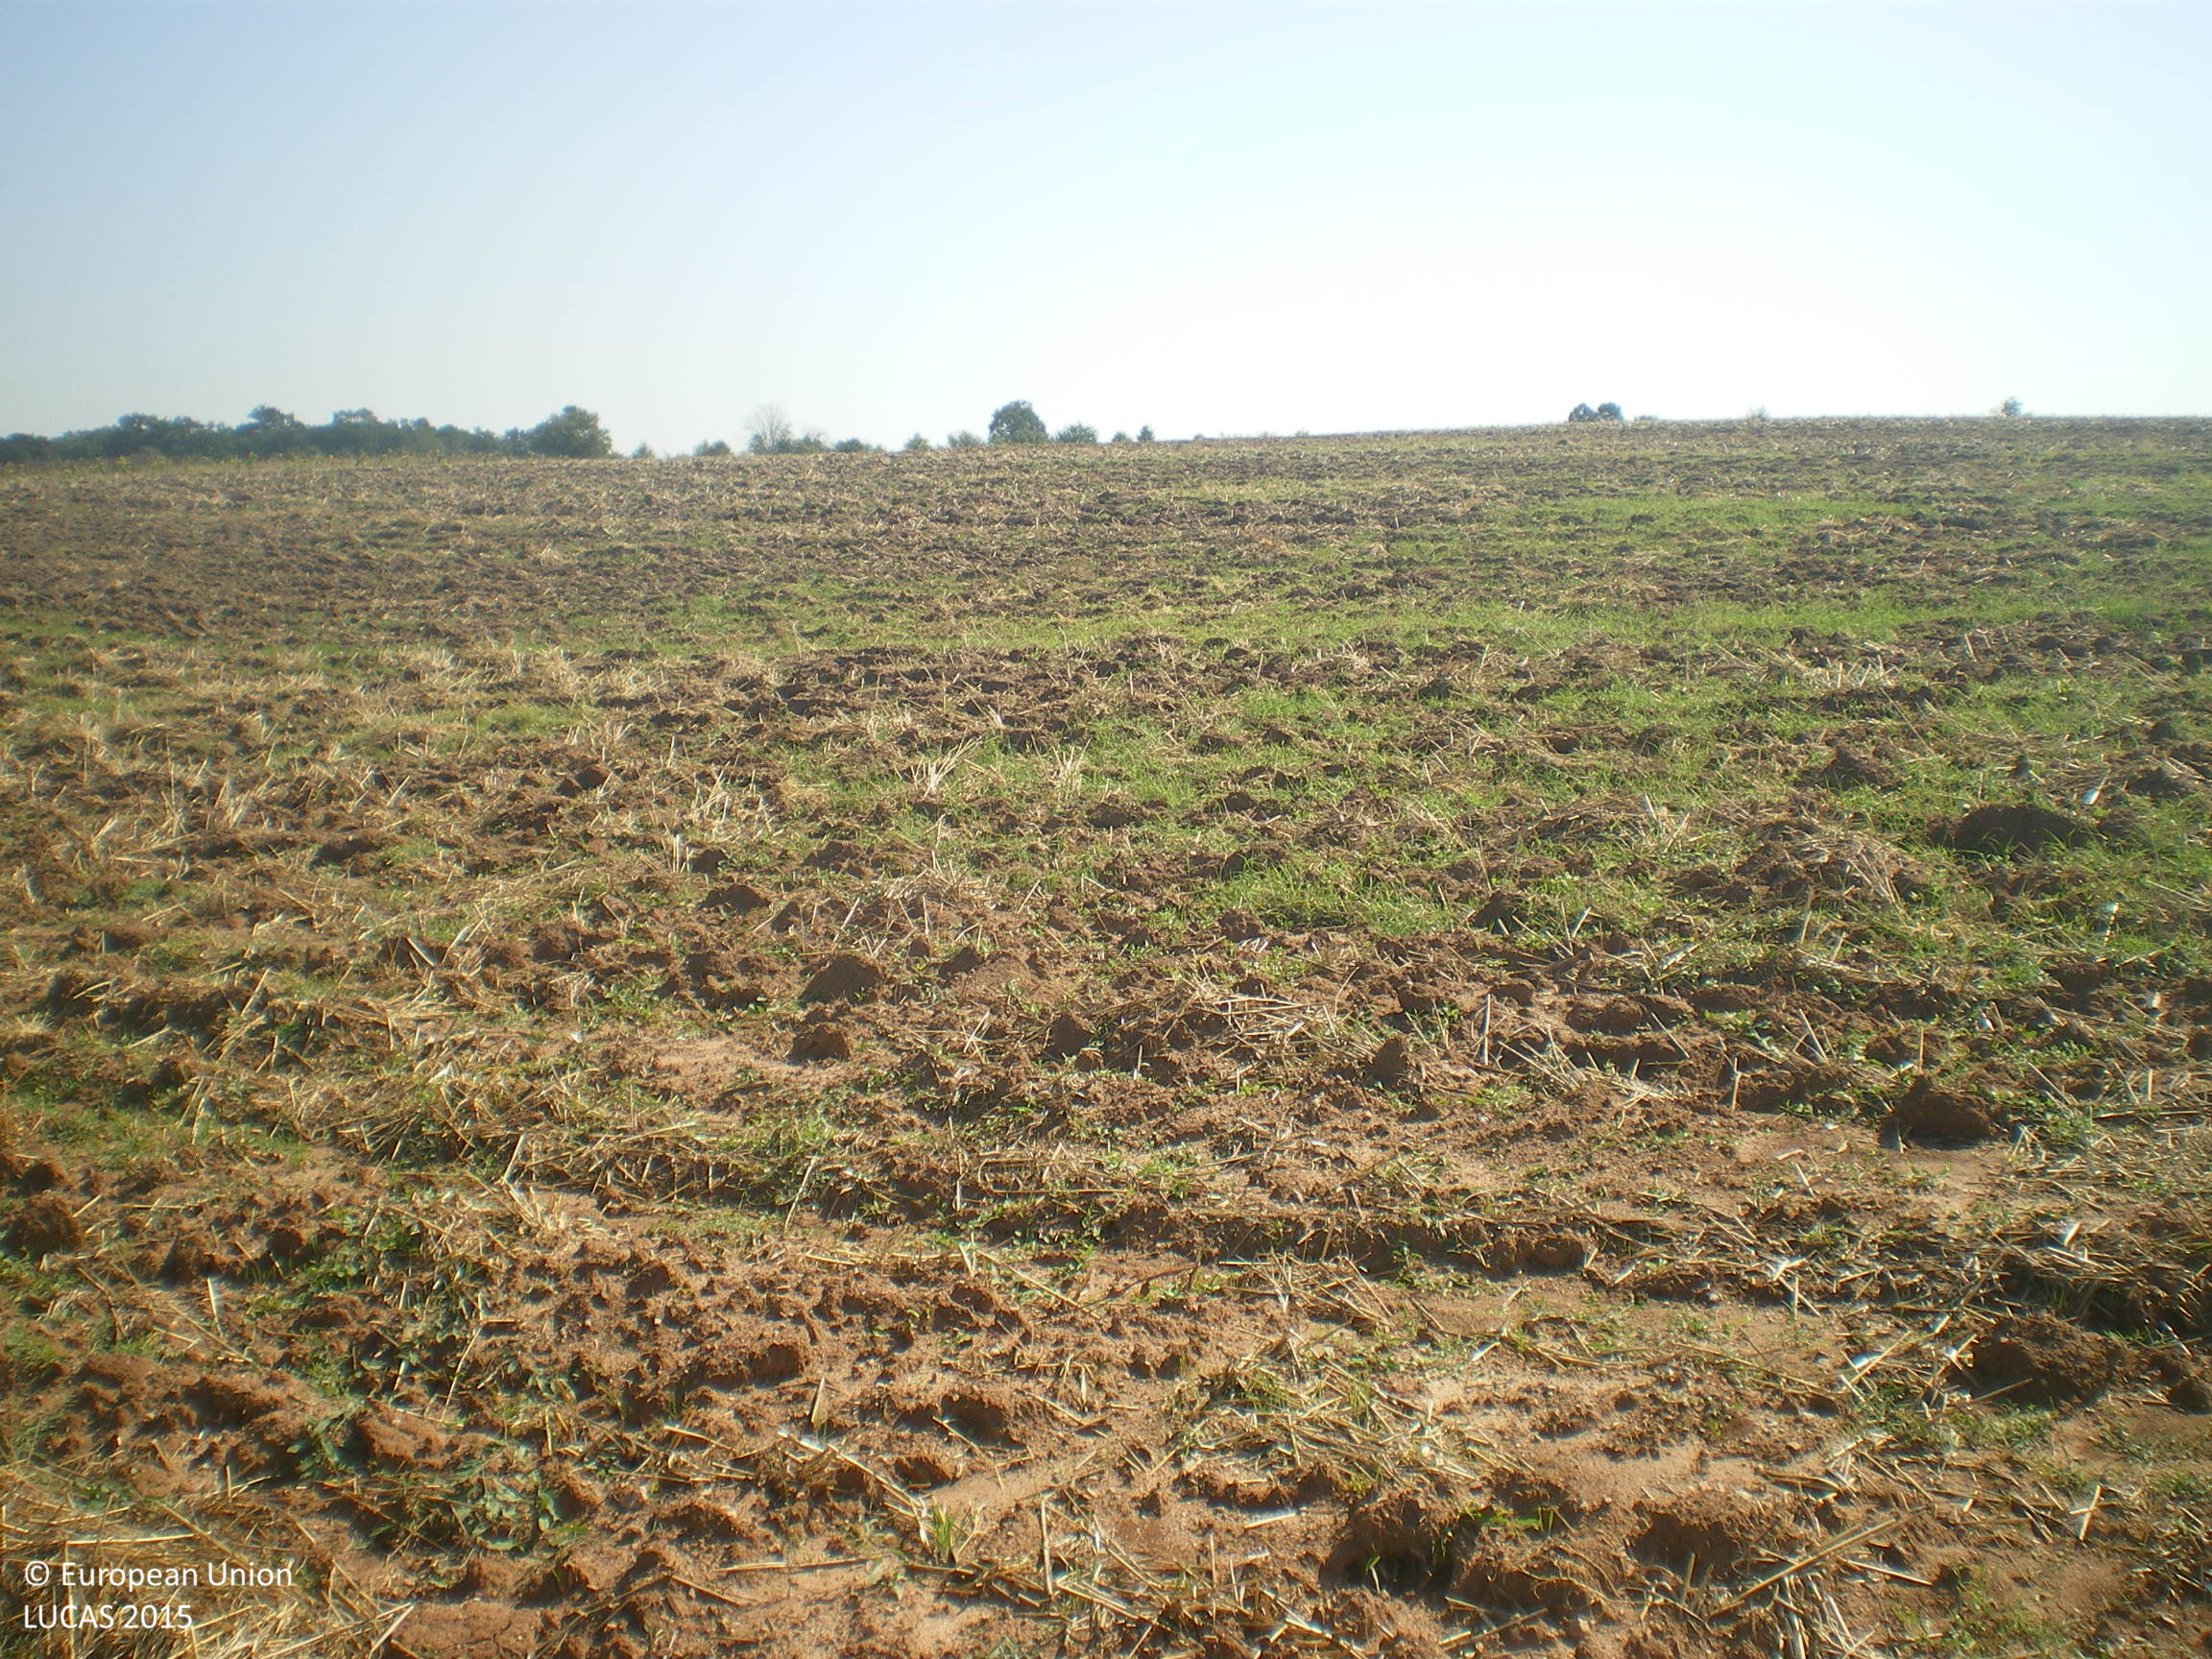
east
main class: Cropland
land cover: Common wheat
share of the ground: < 10 %
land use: Agriculture (excluding fallow land and kitchen gardens)
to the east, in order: Common wheat; Barley; Grass margins; Tracks; Grassland without tree/shrub cover
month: September
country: BG
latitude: 41.7924
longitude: 26.0168
